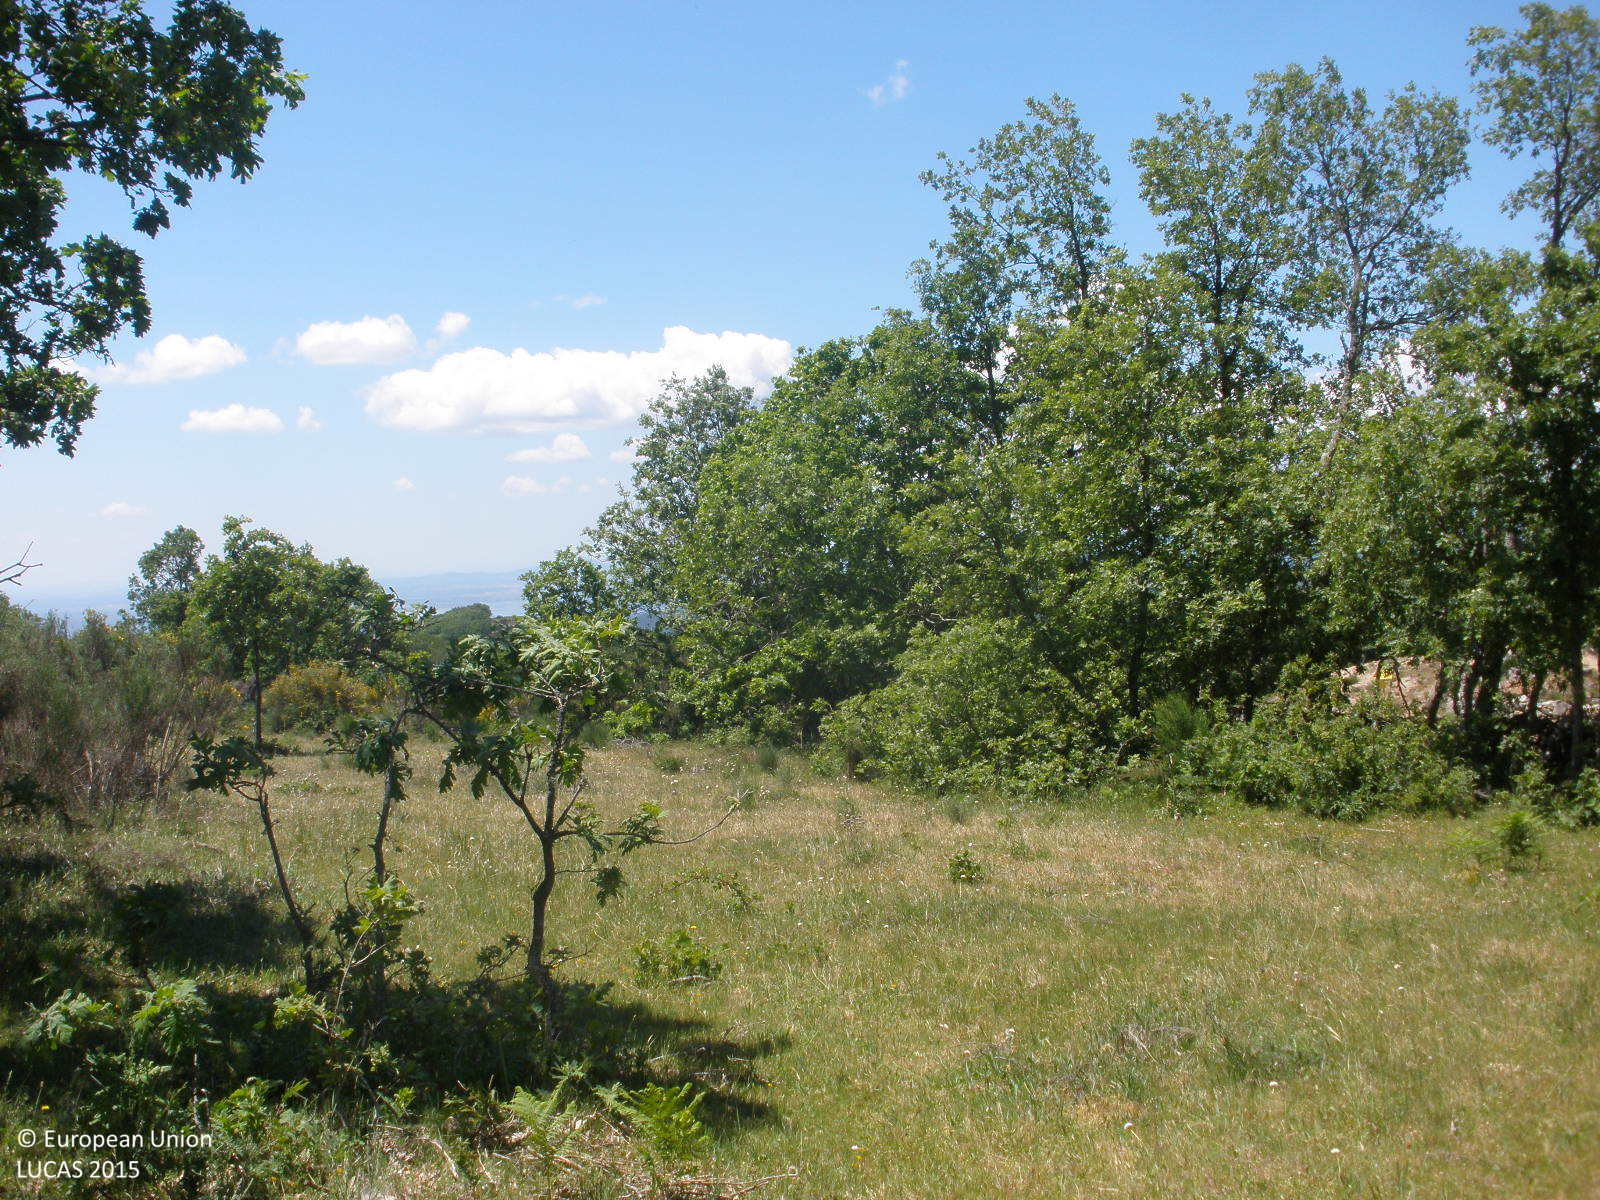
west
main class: Woodland
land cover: Broadleaved woodland
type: broadleaved evergreen forest
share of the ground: > 75 %
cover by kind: broadleaved forest trees 80 %, herbaceous plants 20 %
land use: Agriculture (excluding fallow land and kitchen gardens)
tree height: > 5 m
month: May
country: ES
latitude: 40.3224
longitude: -5.9014
